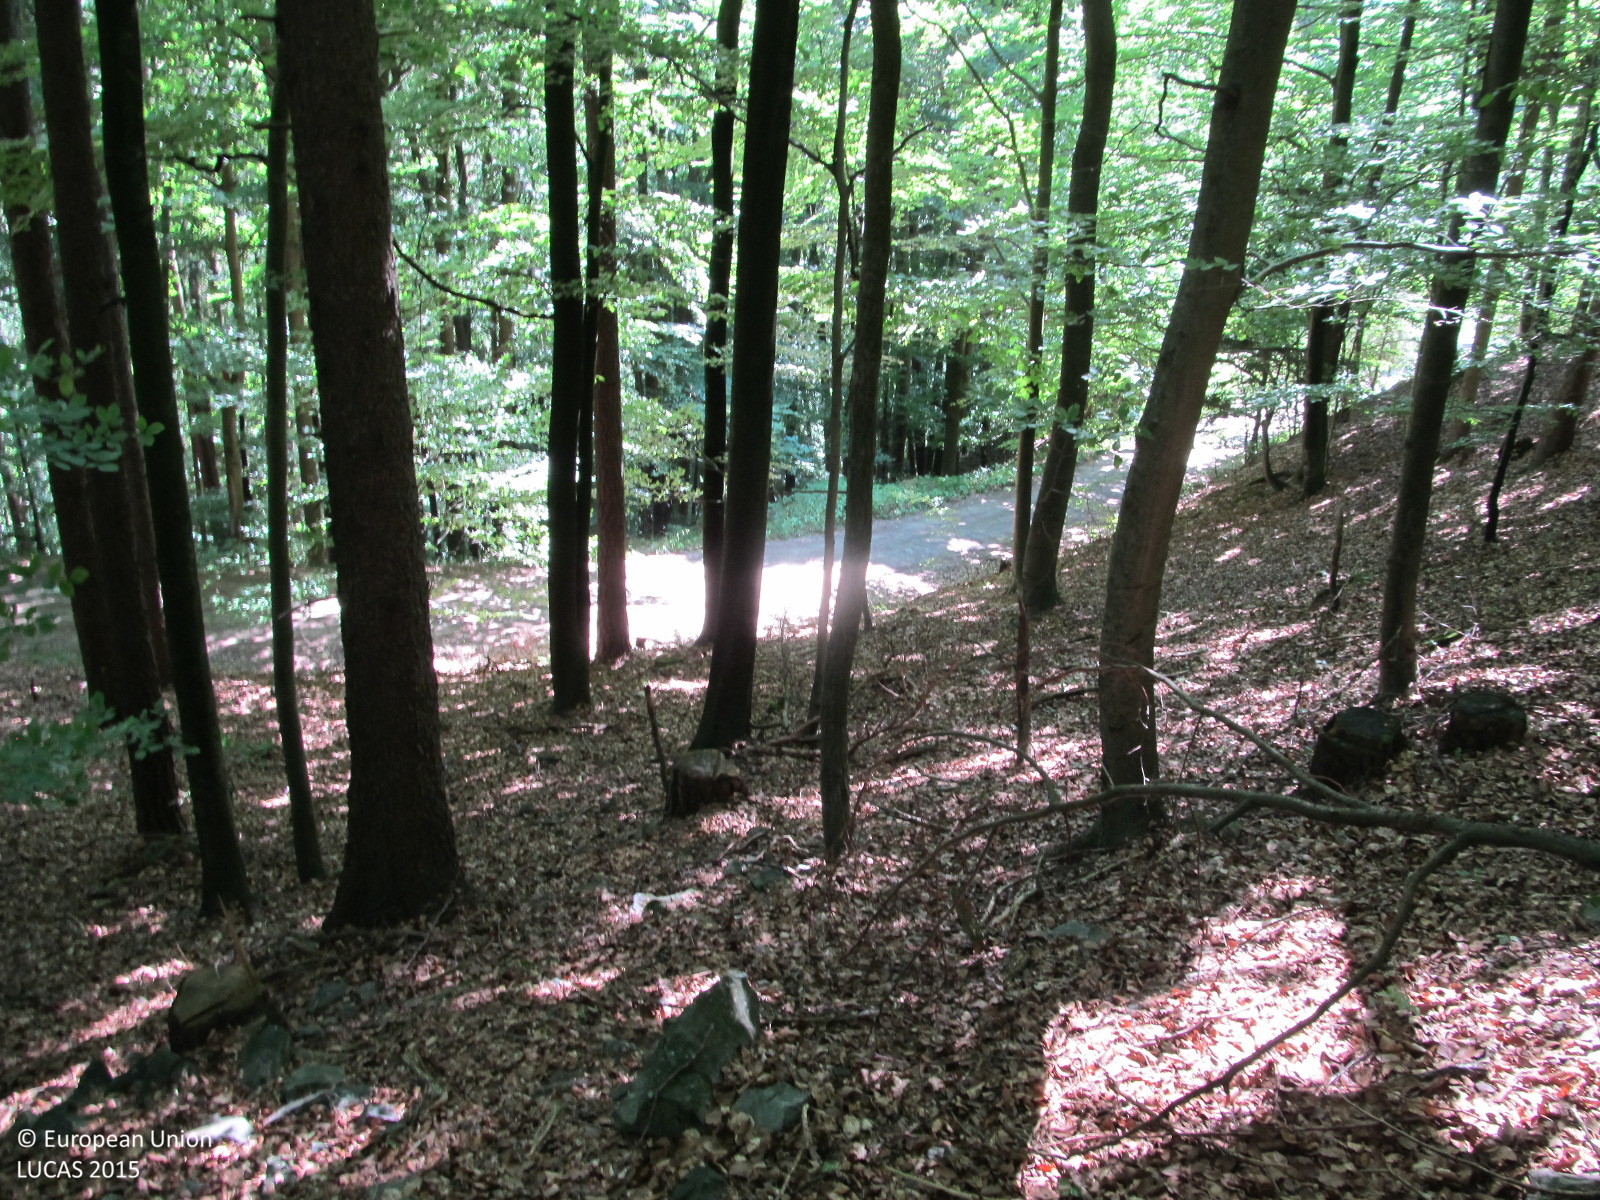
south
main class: Woodland
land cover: Other mixed woodland
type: beech forest
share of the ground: > 75 %
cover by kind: broadleaved forest trees 60 %, coniferous forest trees 25 %, unconsolidated bare surface 10 %, shrubs 5 %
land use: Forestry
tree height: > 5 m
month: July
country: AT
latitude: 48.2906
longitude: 15.3800
